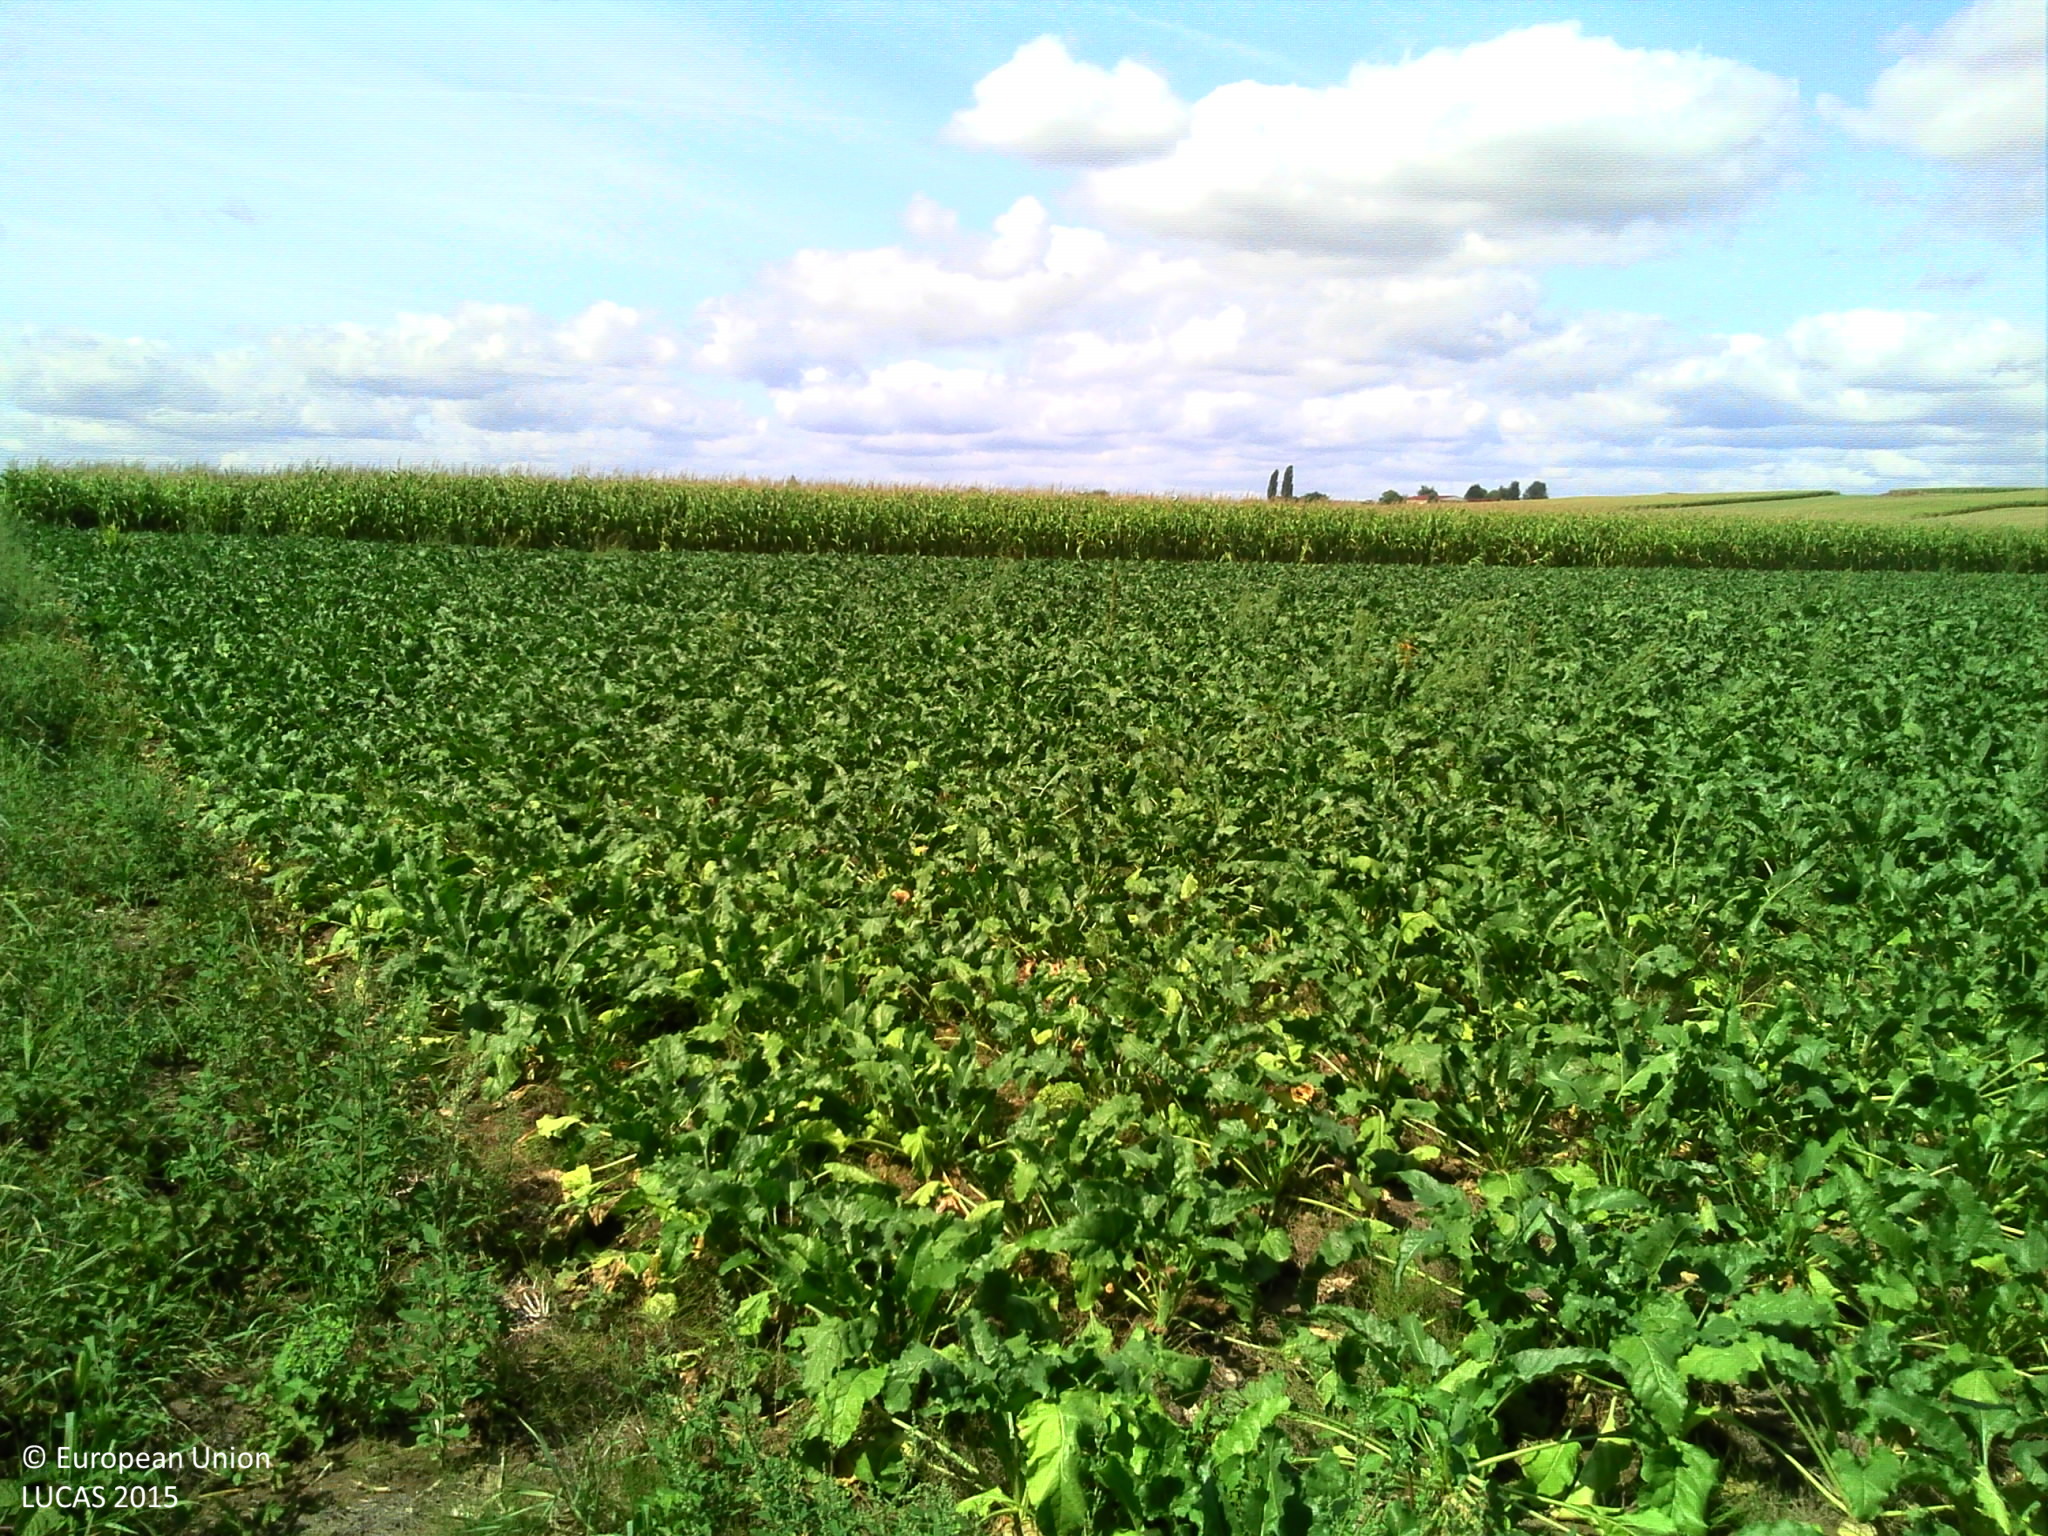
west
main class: Cropland
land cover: Sugar beet
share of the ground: > 75 %
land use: Agriculture (excluding fallow land and kitchen gardens)
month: August
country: FR
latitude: 48.7559
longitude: 7.6203
